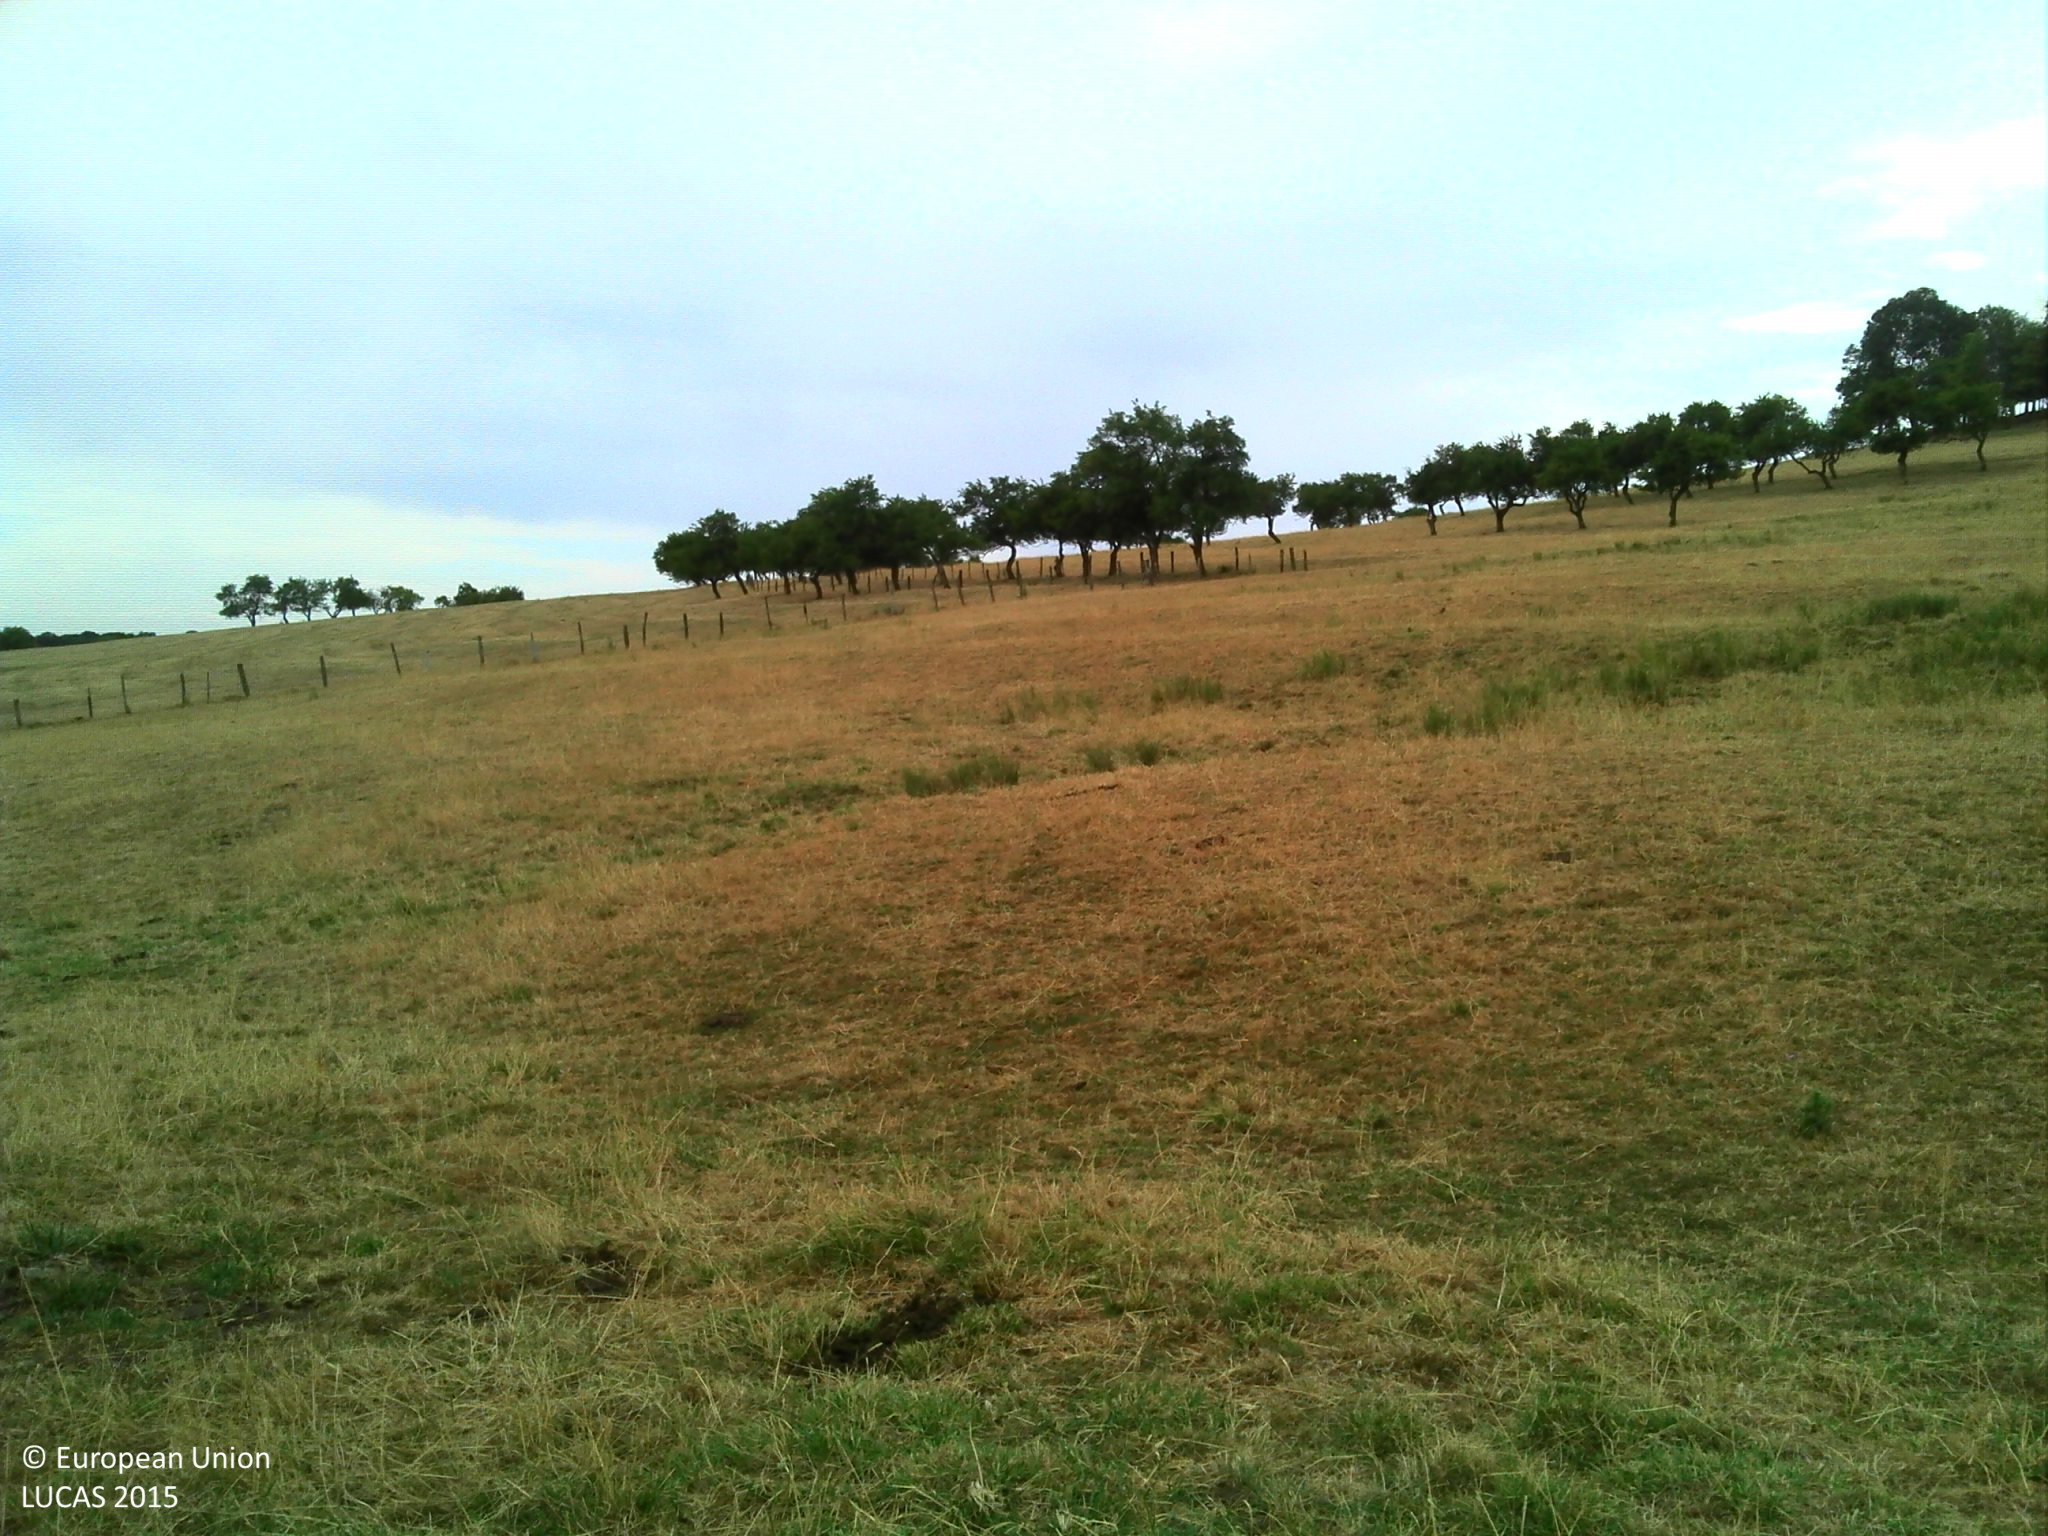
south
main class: Grassland
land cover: Grassland without tree/shrub cover
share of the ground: > 75 %
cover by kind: herbaceous plants 100 %
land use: Agriculture (excluding fallow land and kitchen gardens)
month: July
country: FR
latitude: 48.3877
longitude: 6.0705
